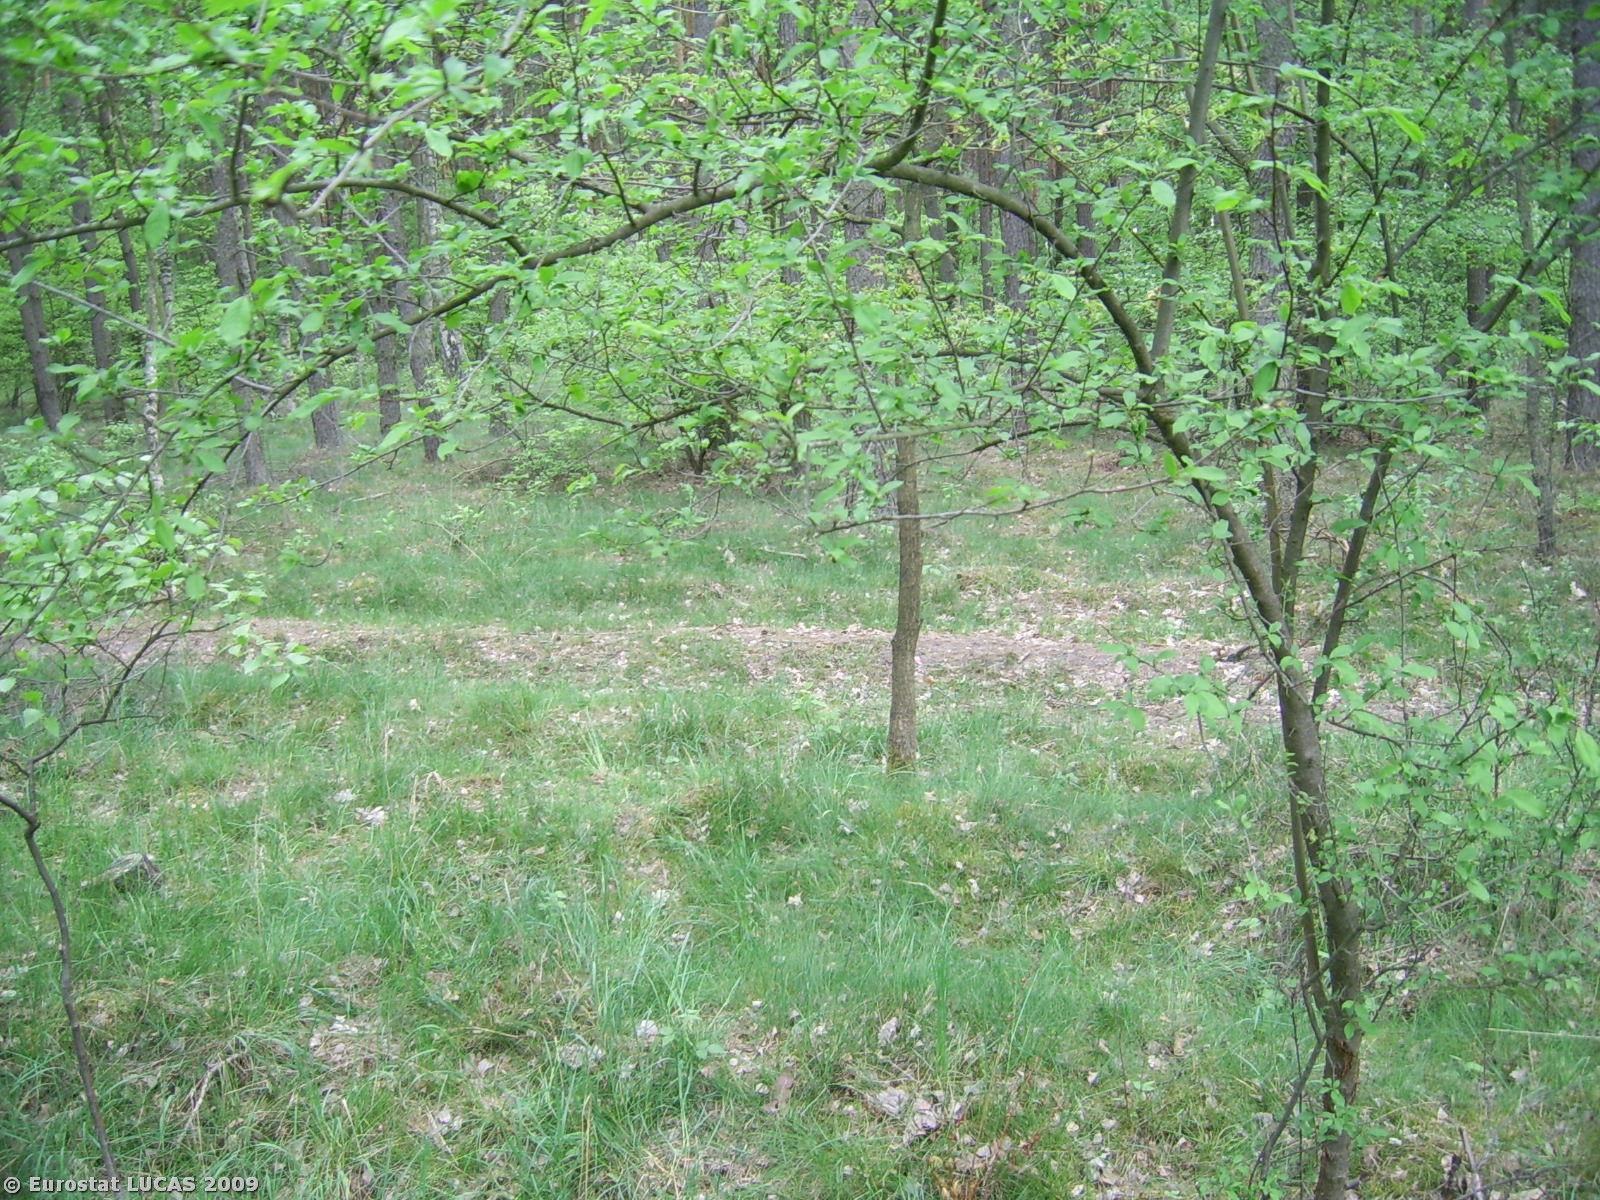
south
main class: Woodland
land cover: Mixed woodland
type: hemiboreal forest and nemoral coniferous forest and mixed broadleaved-coniferous forest
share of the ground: 50 - 75 %
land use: Forestry
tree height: > 5 m
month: May
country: PL
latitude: 52.6397
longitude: 17.5939
